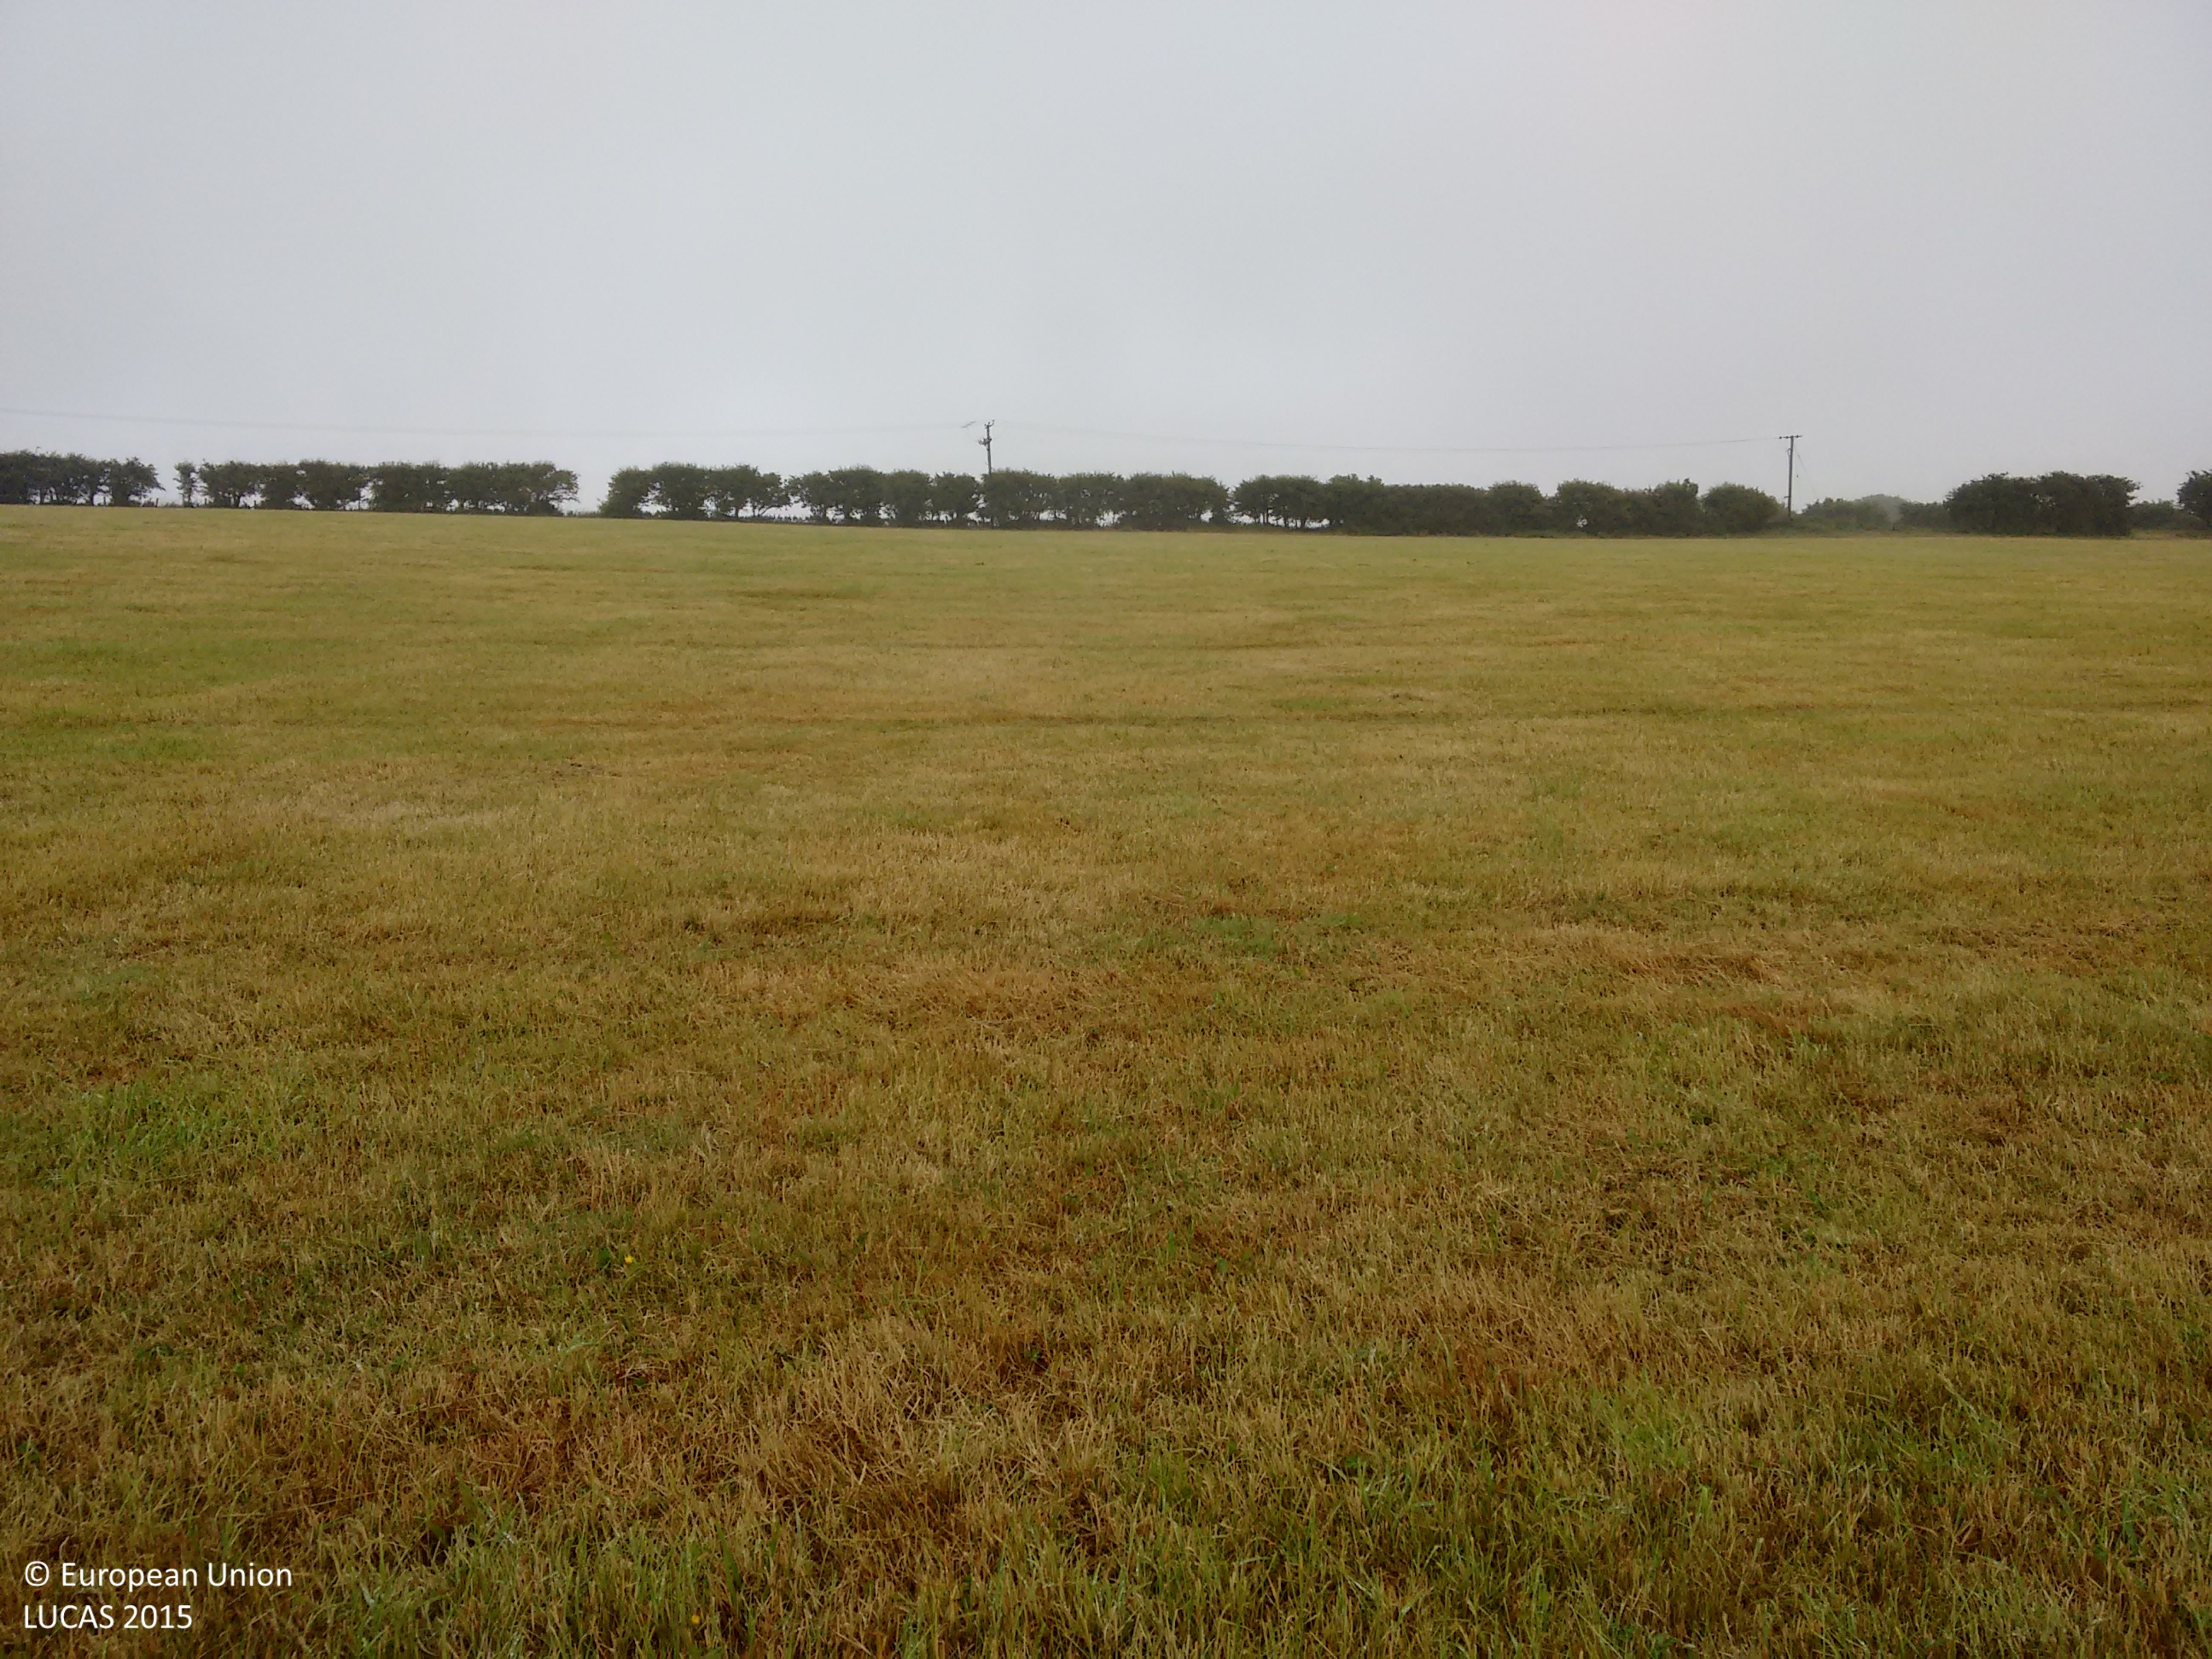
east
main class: Grassland
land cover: Grassland without tree/shrub cover
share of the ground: > 75 %
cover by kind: herbaceous plants 100 %
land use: Agriculture (excluding fallow land and kitchen gardens)
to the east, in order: Grassland without tree/shrub cover; Managed hedges; Fences; Electric lines; Grassland without tree/shrub cover
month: July
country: GB
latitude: 51.4565
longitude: -3.3361
